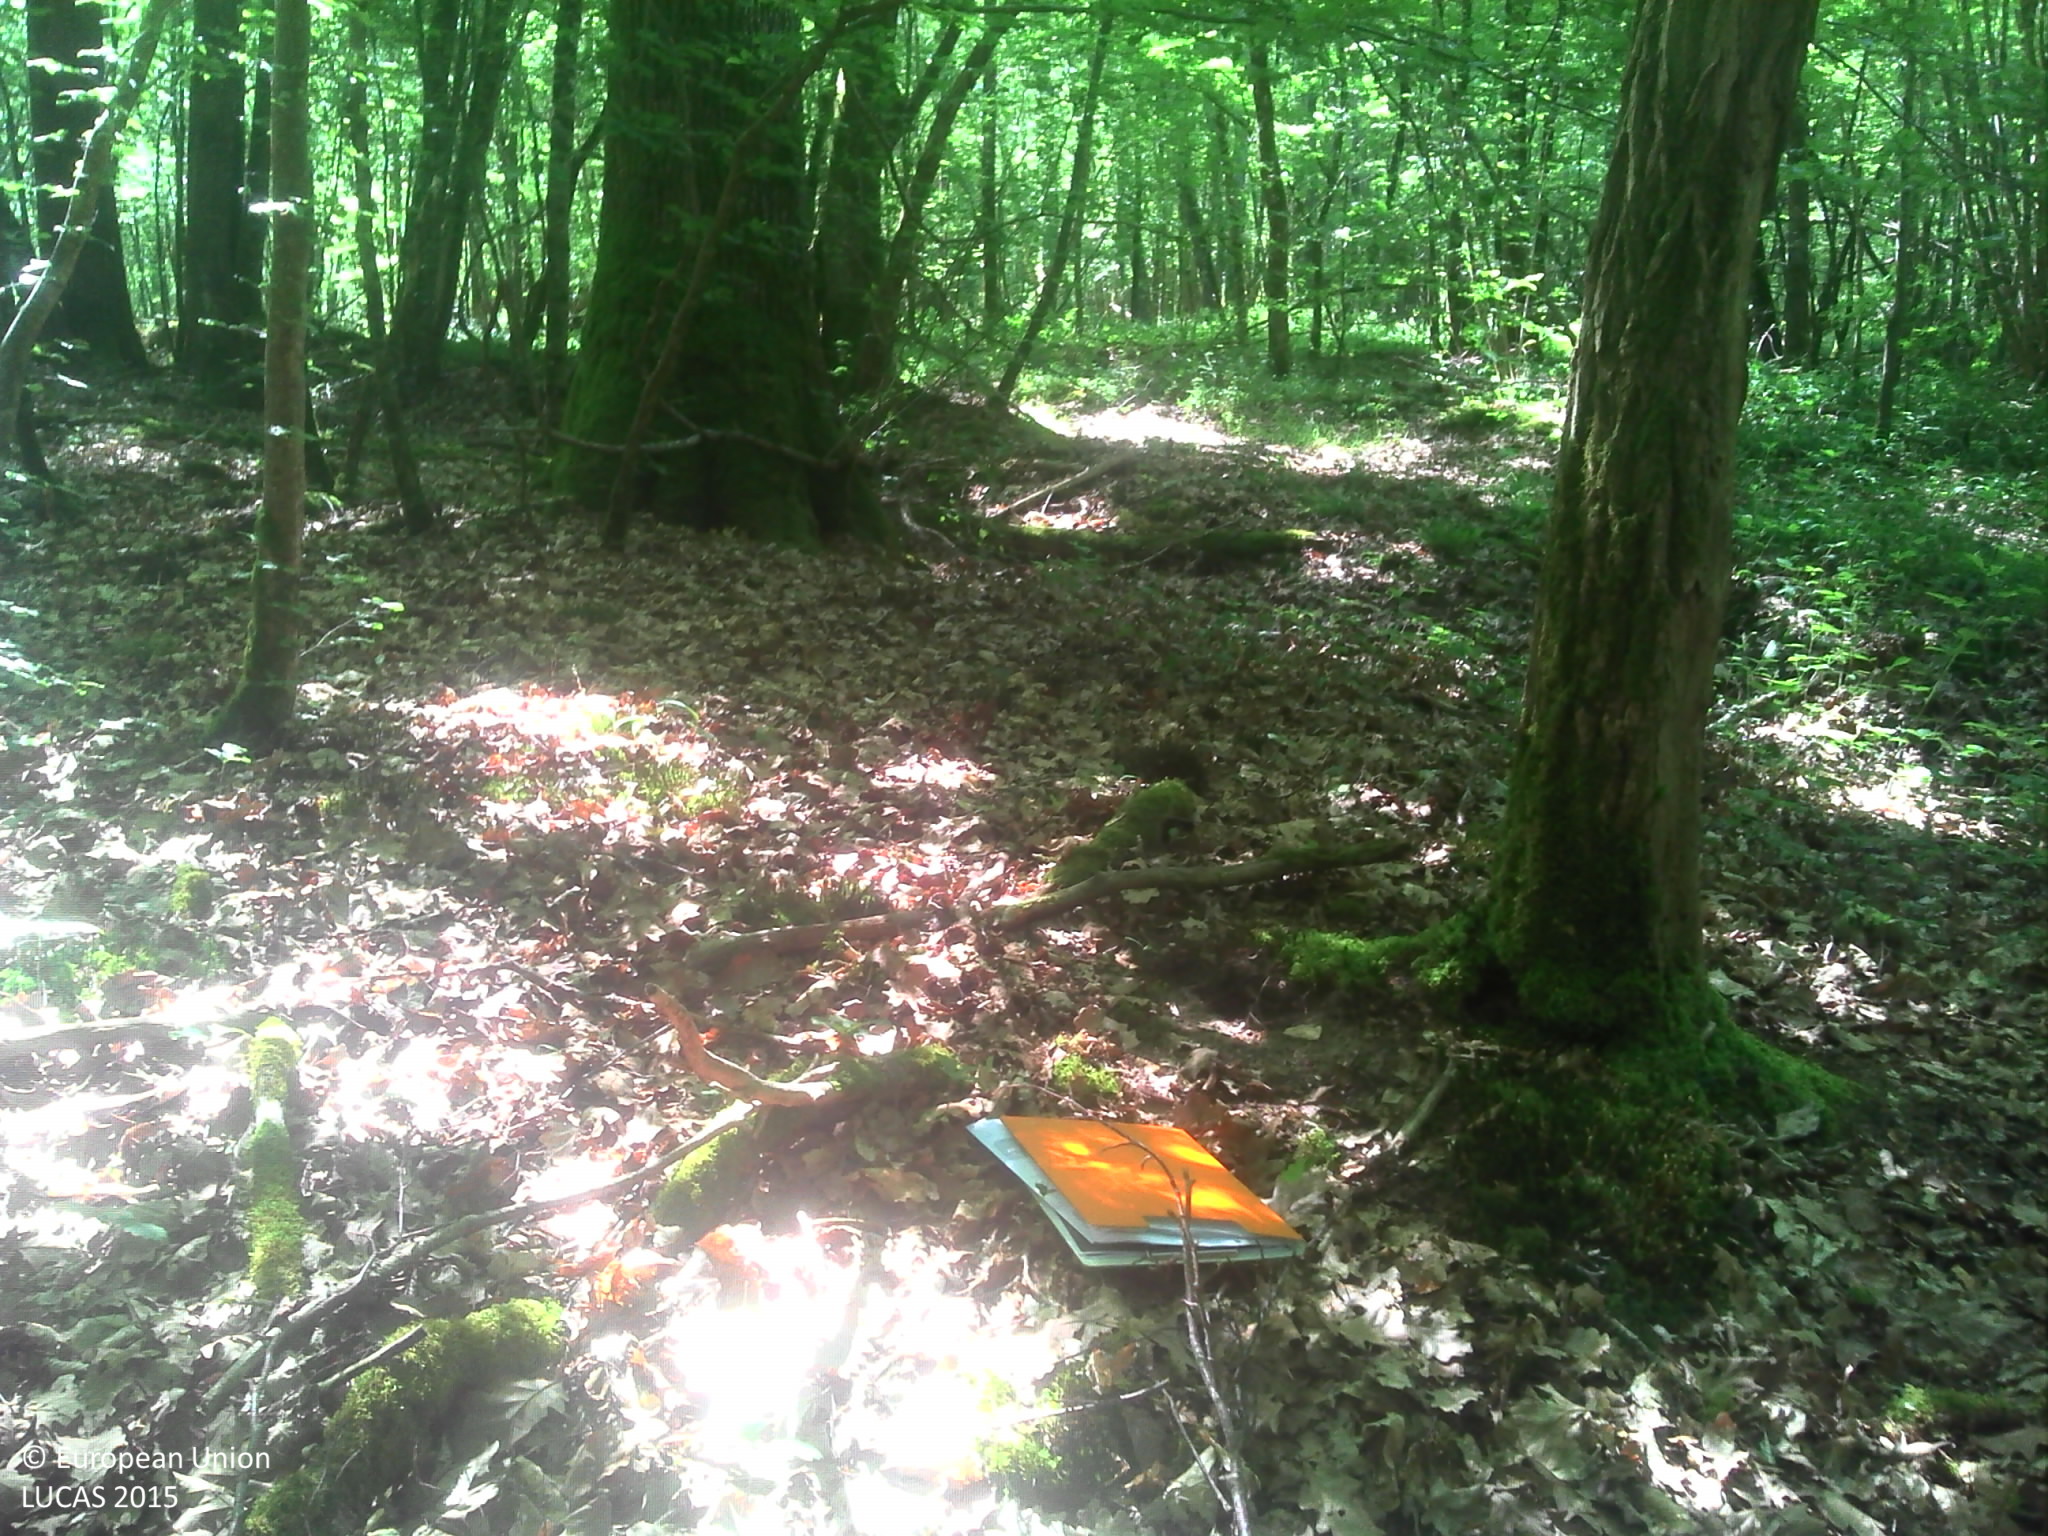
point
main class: Woodland
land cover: Broadleaved woodland
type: acidophilous oak and oak-birch forest
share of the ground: > 75 %
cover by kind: broadleaved forest trees 85 %, herbaceous plants 10 %, coniferous forest trees 5 %
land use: Forestry
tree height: > 5 m
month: June
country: FR
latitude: 48.4034
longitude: 4.7163
